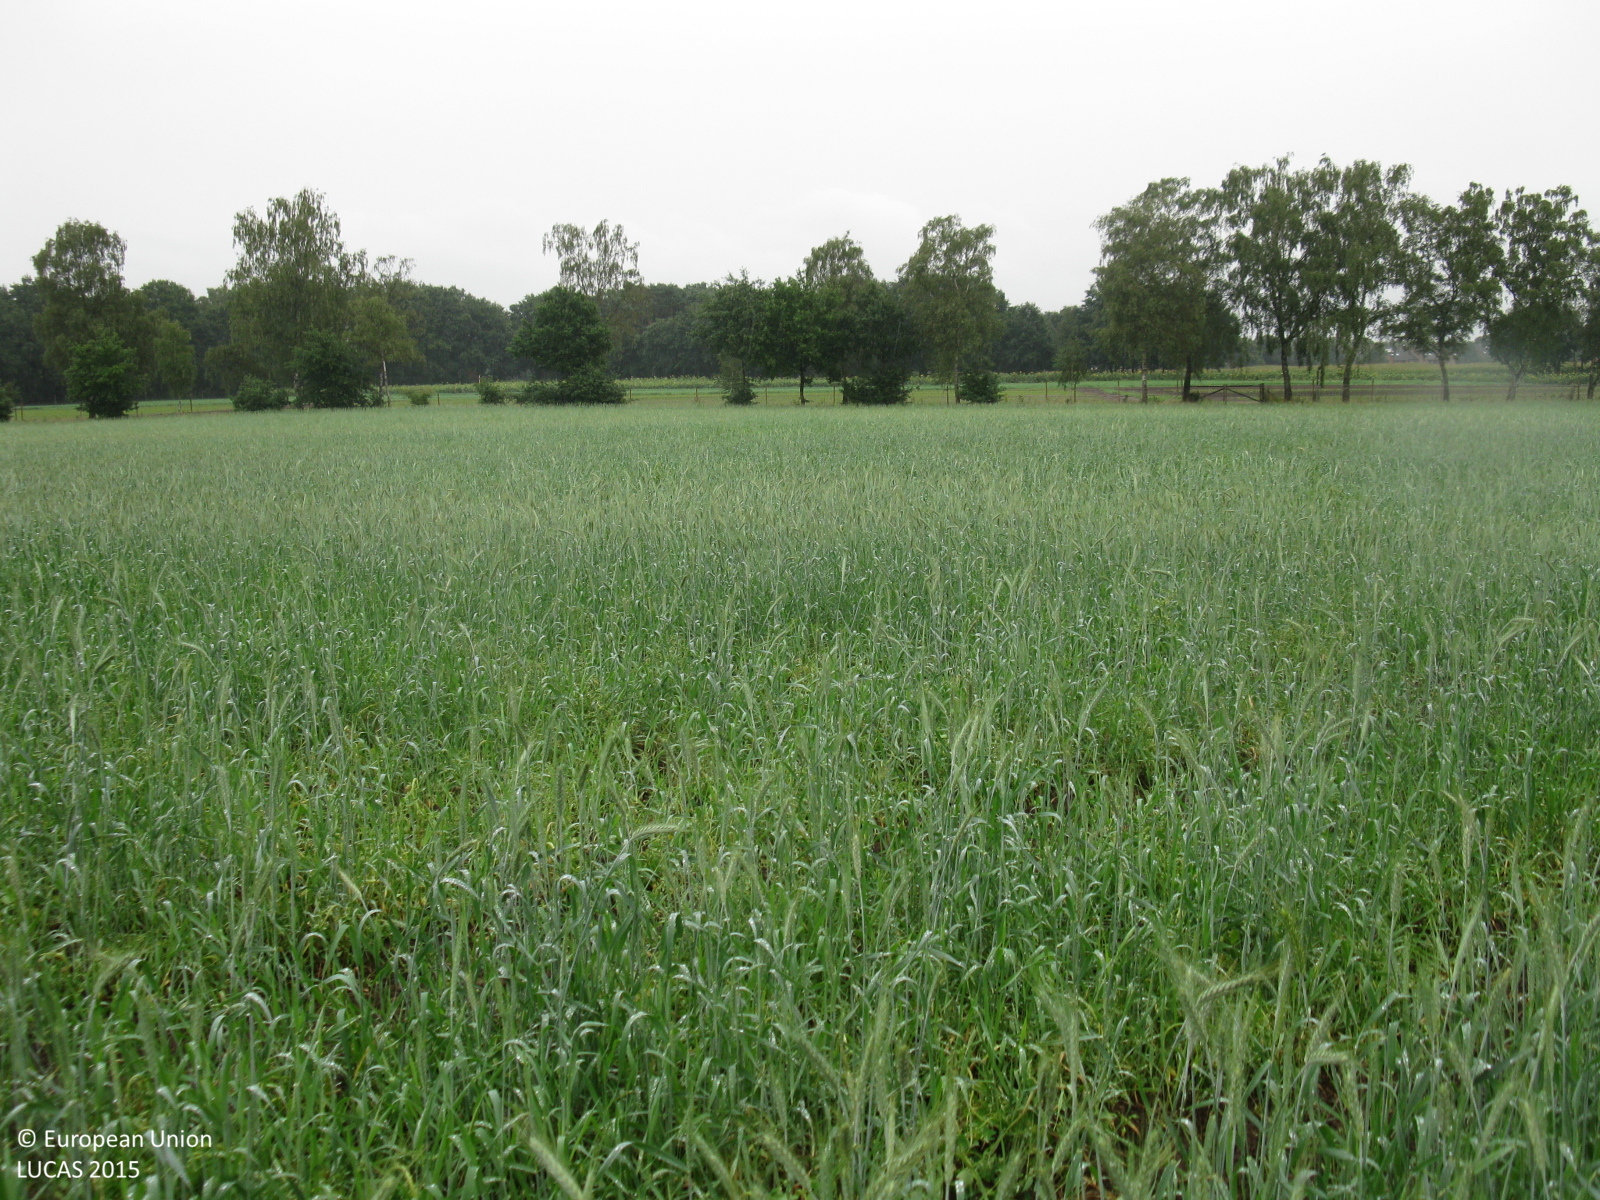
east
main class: Cropland
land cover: Rye
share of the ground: > 75 %
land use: Agriculture (excluding fallow land and kitchen gardens)
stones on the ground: < 10 %
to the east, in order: Rye; Lines of trees; Paved roads, cycling and walking lanes; Lines of trees; Tracks; Grass margins; Fences; Strawberries
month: August
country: DE
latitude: 51.6907
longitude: 6.9476
